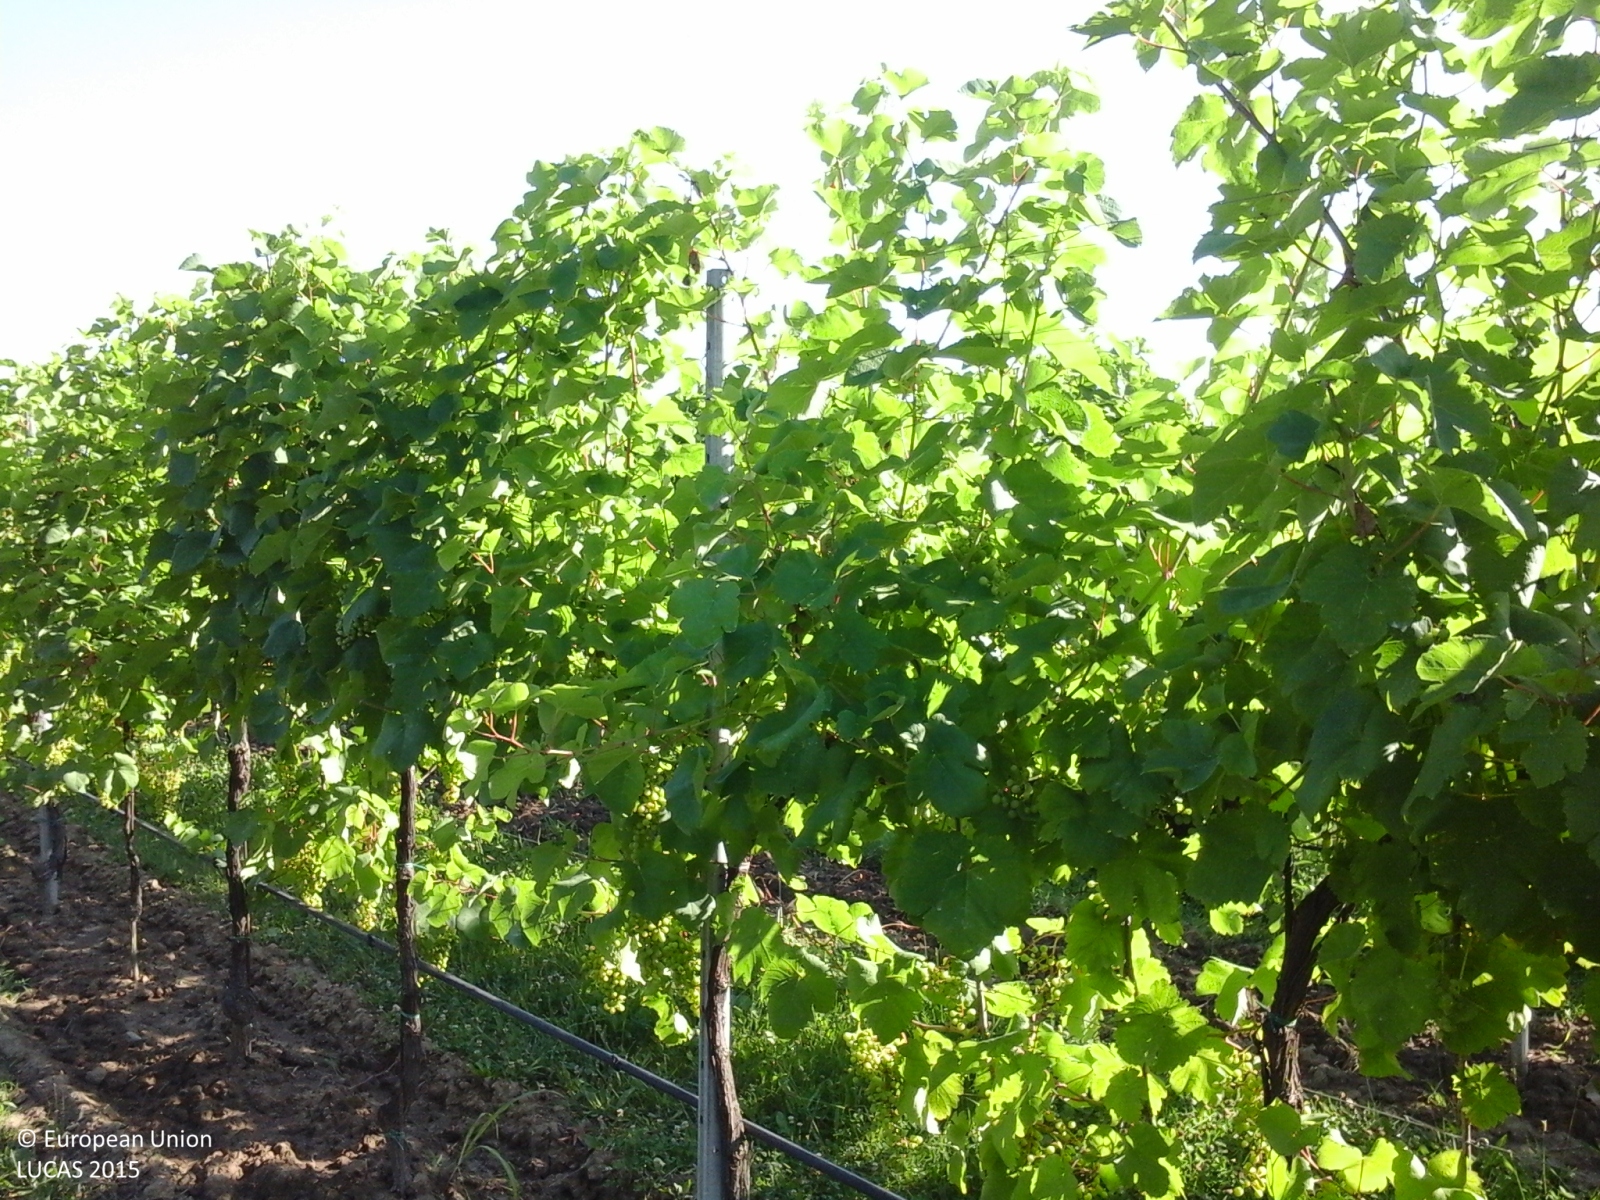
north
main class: Cropland
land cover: Vineyards
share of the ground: 50 - 75 %
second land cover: Grassland without tree/shrub cover
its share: > 75 %
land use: Agriculture (excluding fallow land and kitchen gardens)
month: July
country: IT
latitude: 45.7133
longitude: 12.3218
